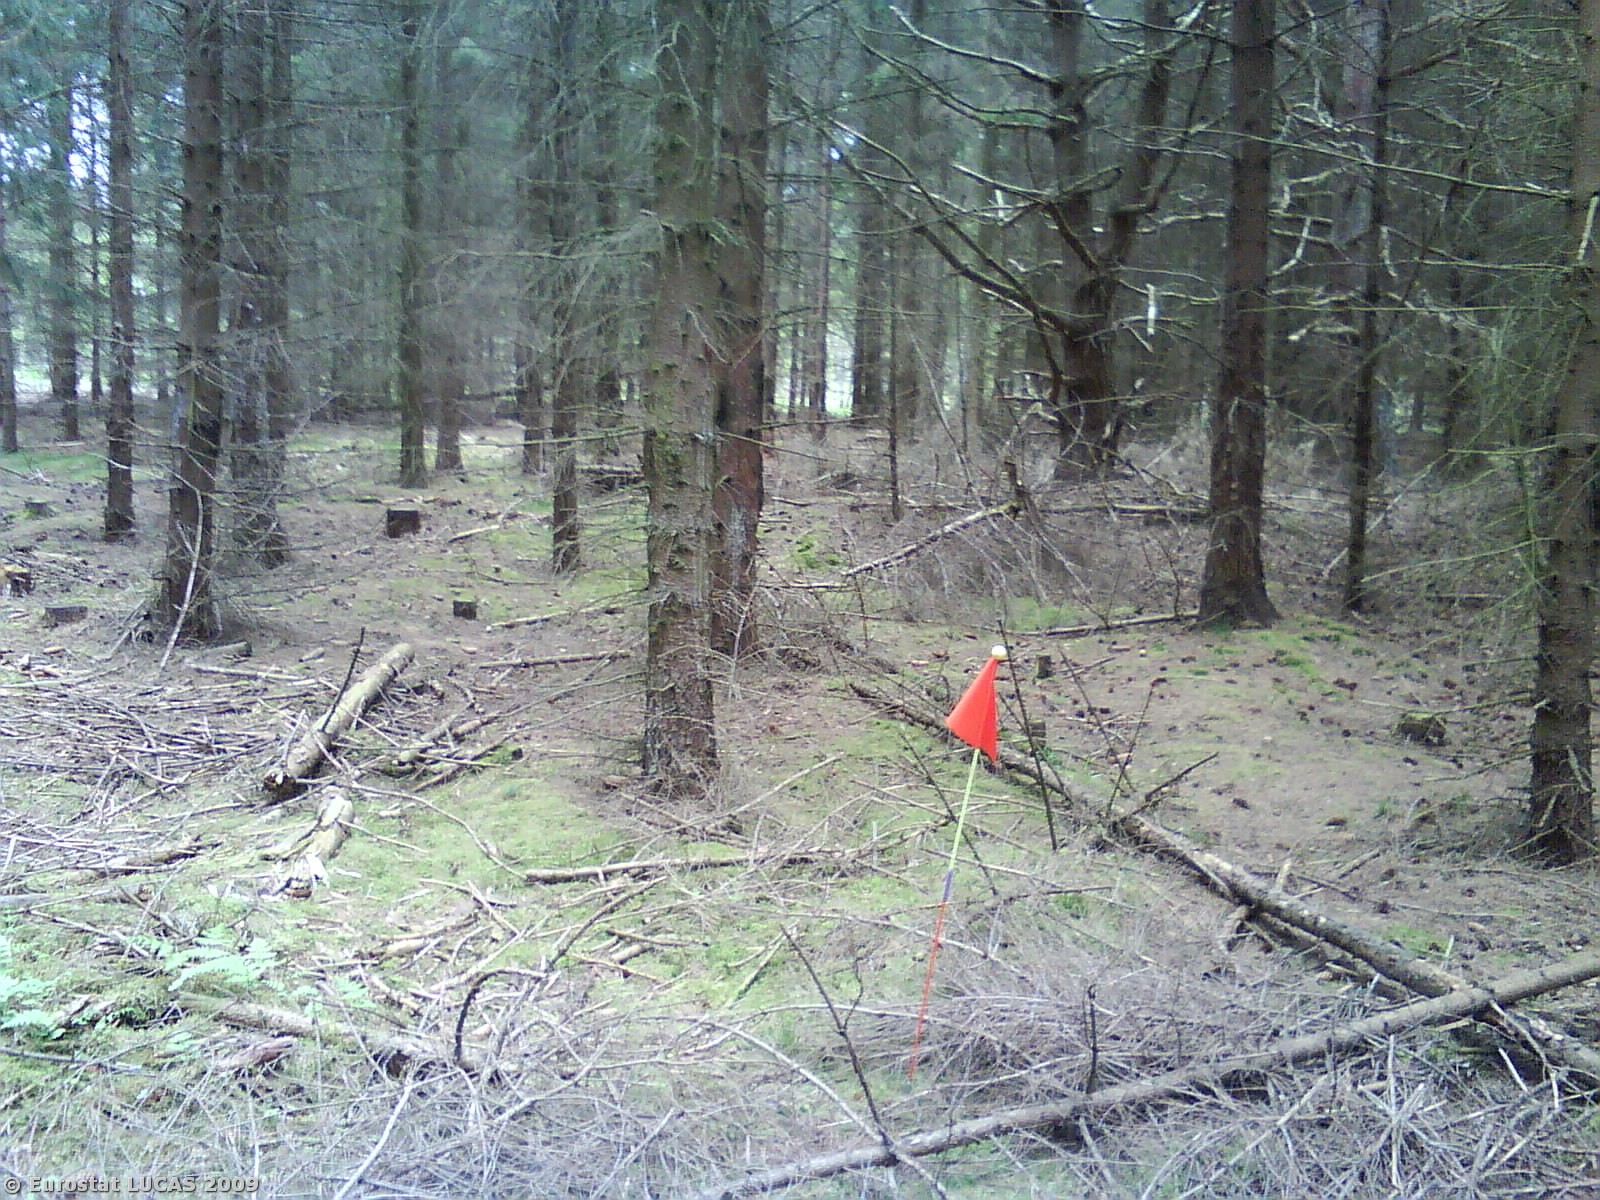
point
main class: Woodland
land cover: Coniferous woodland
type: hemiboreal forest and nemoral coniferous forest and mixed broadleaved-coniferous forest
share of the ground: 25 - 50 %
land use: Forestry
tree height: > 5 m
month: May
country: DK
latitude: 56.5091
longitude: 10.7627
